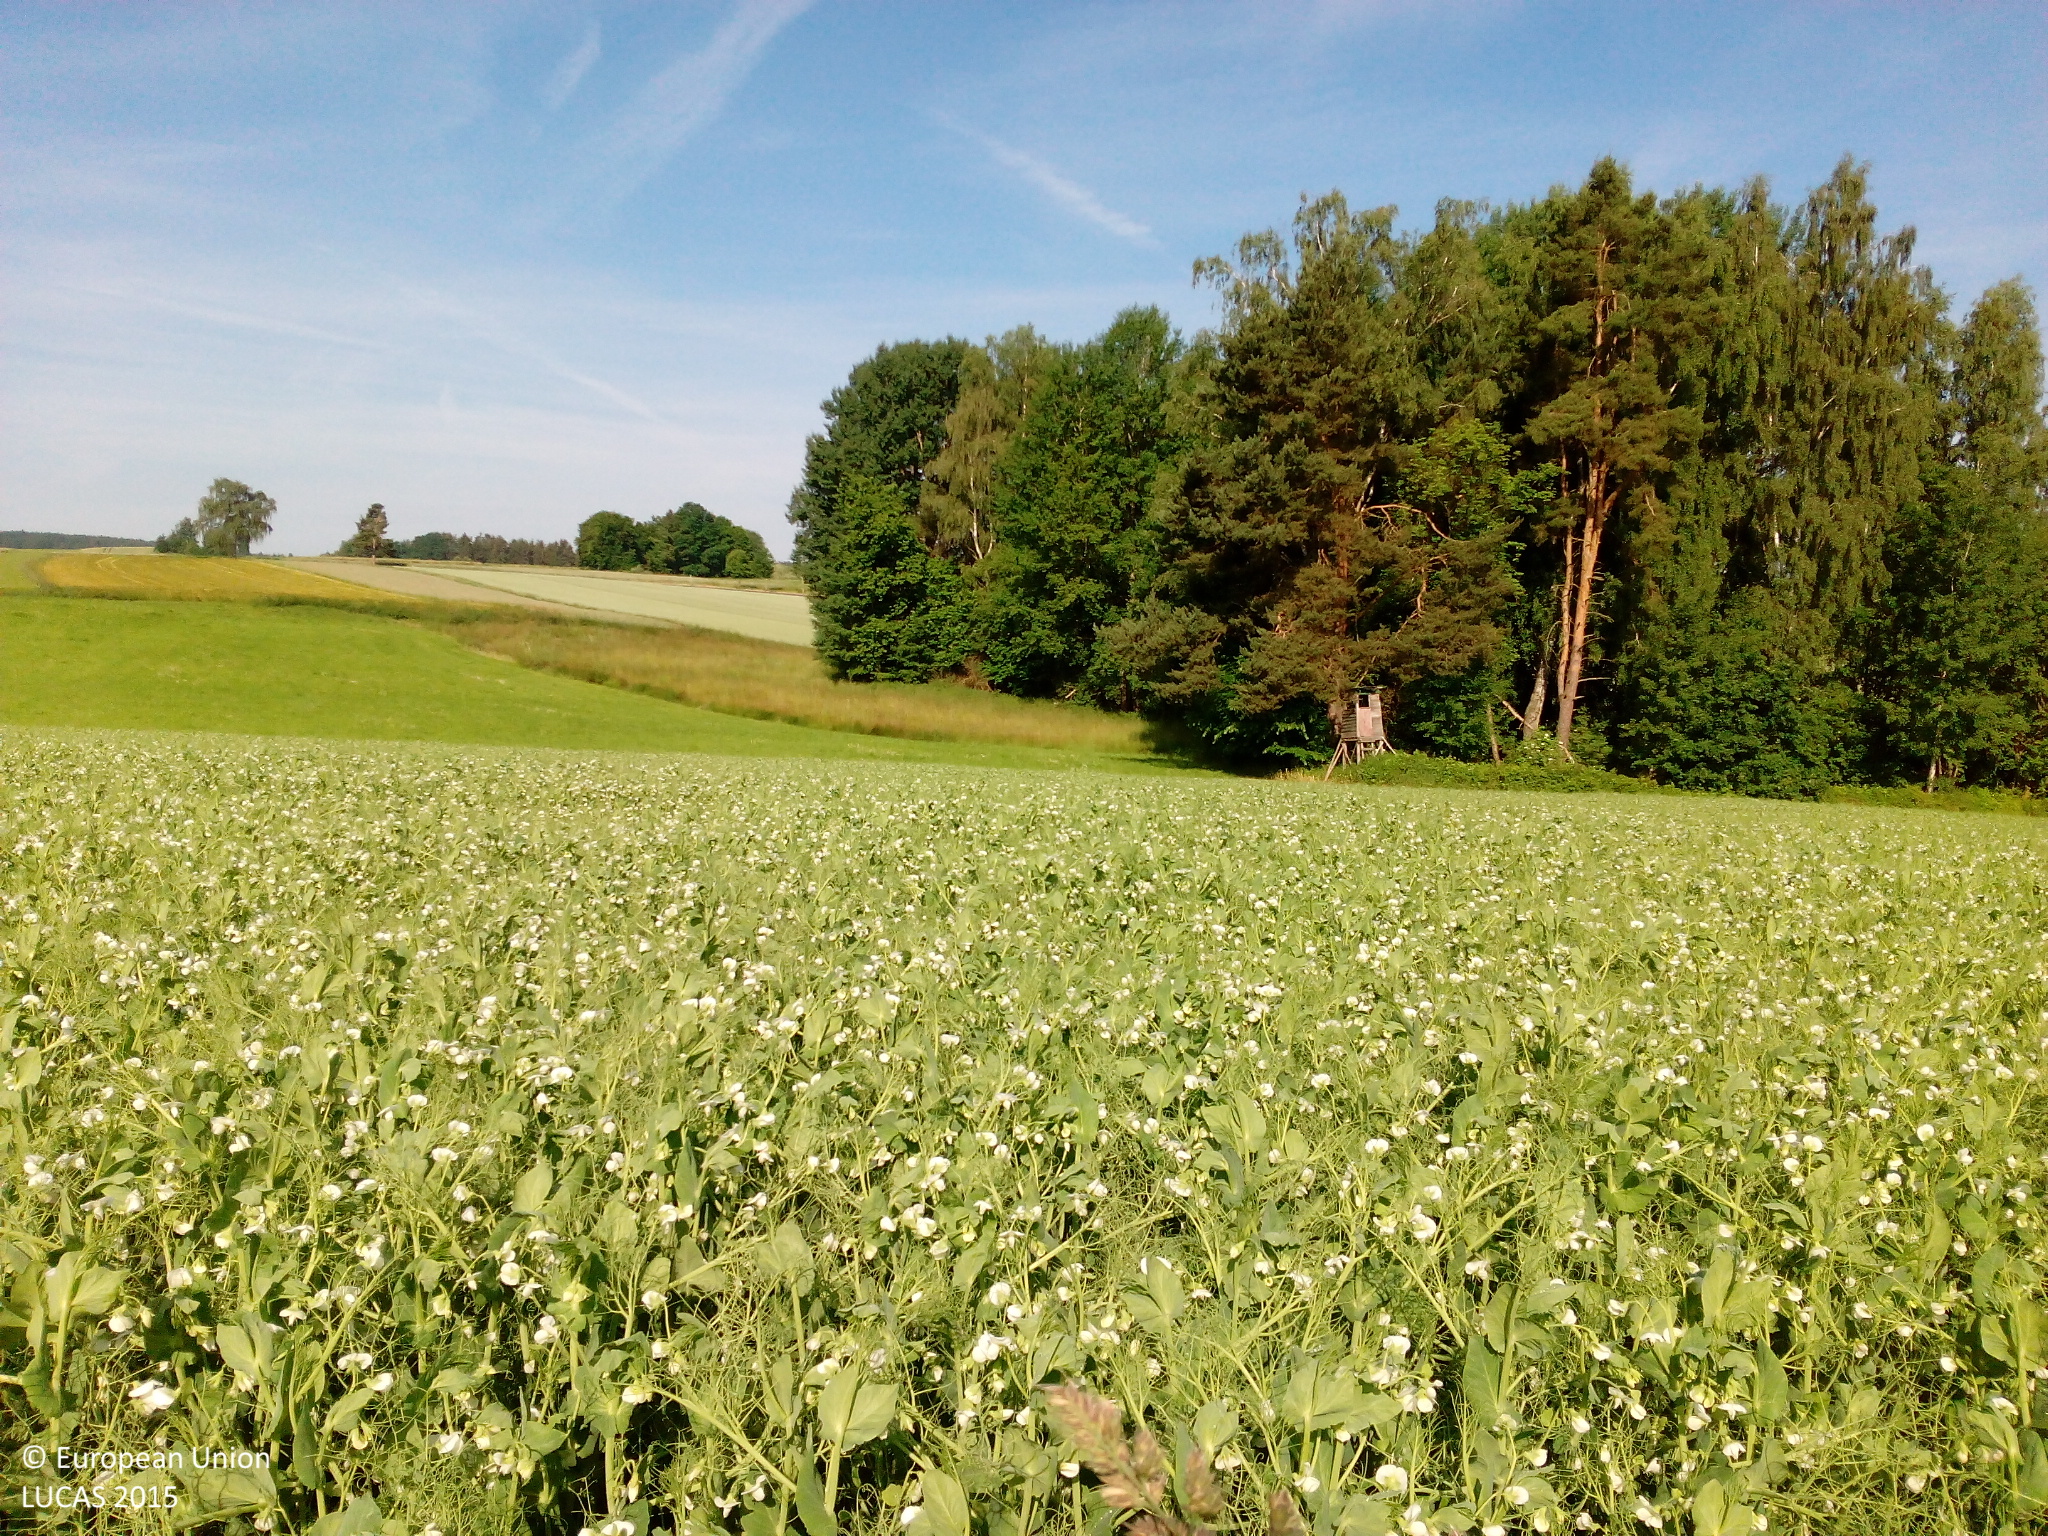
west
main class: Cropland
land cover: Dry pulses
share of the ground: > 75 %
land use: Agriculture (excluding fallow land and kitchen gardens)
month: June
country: DE
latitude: 49.9788
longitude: 12.4121
